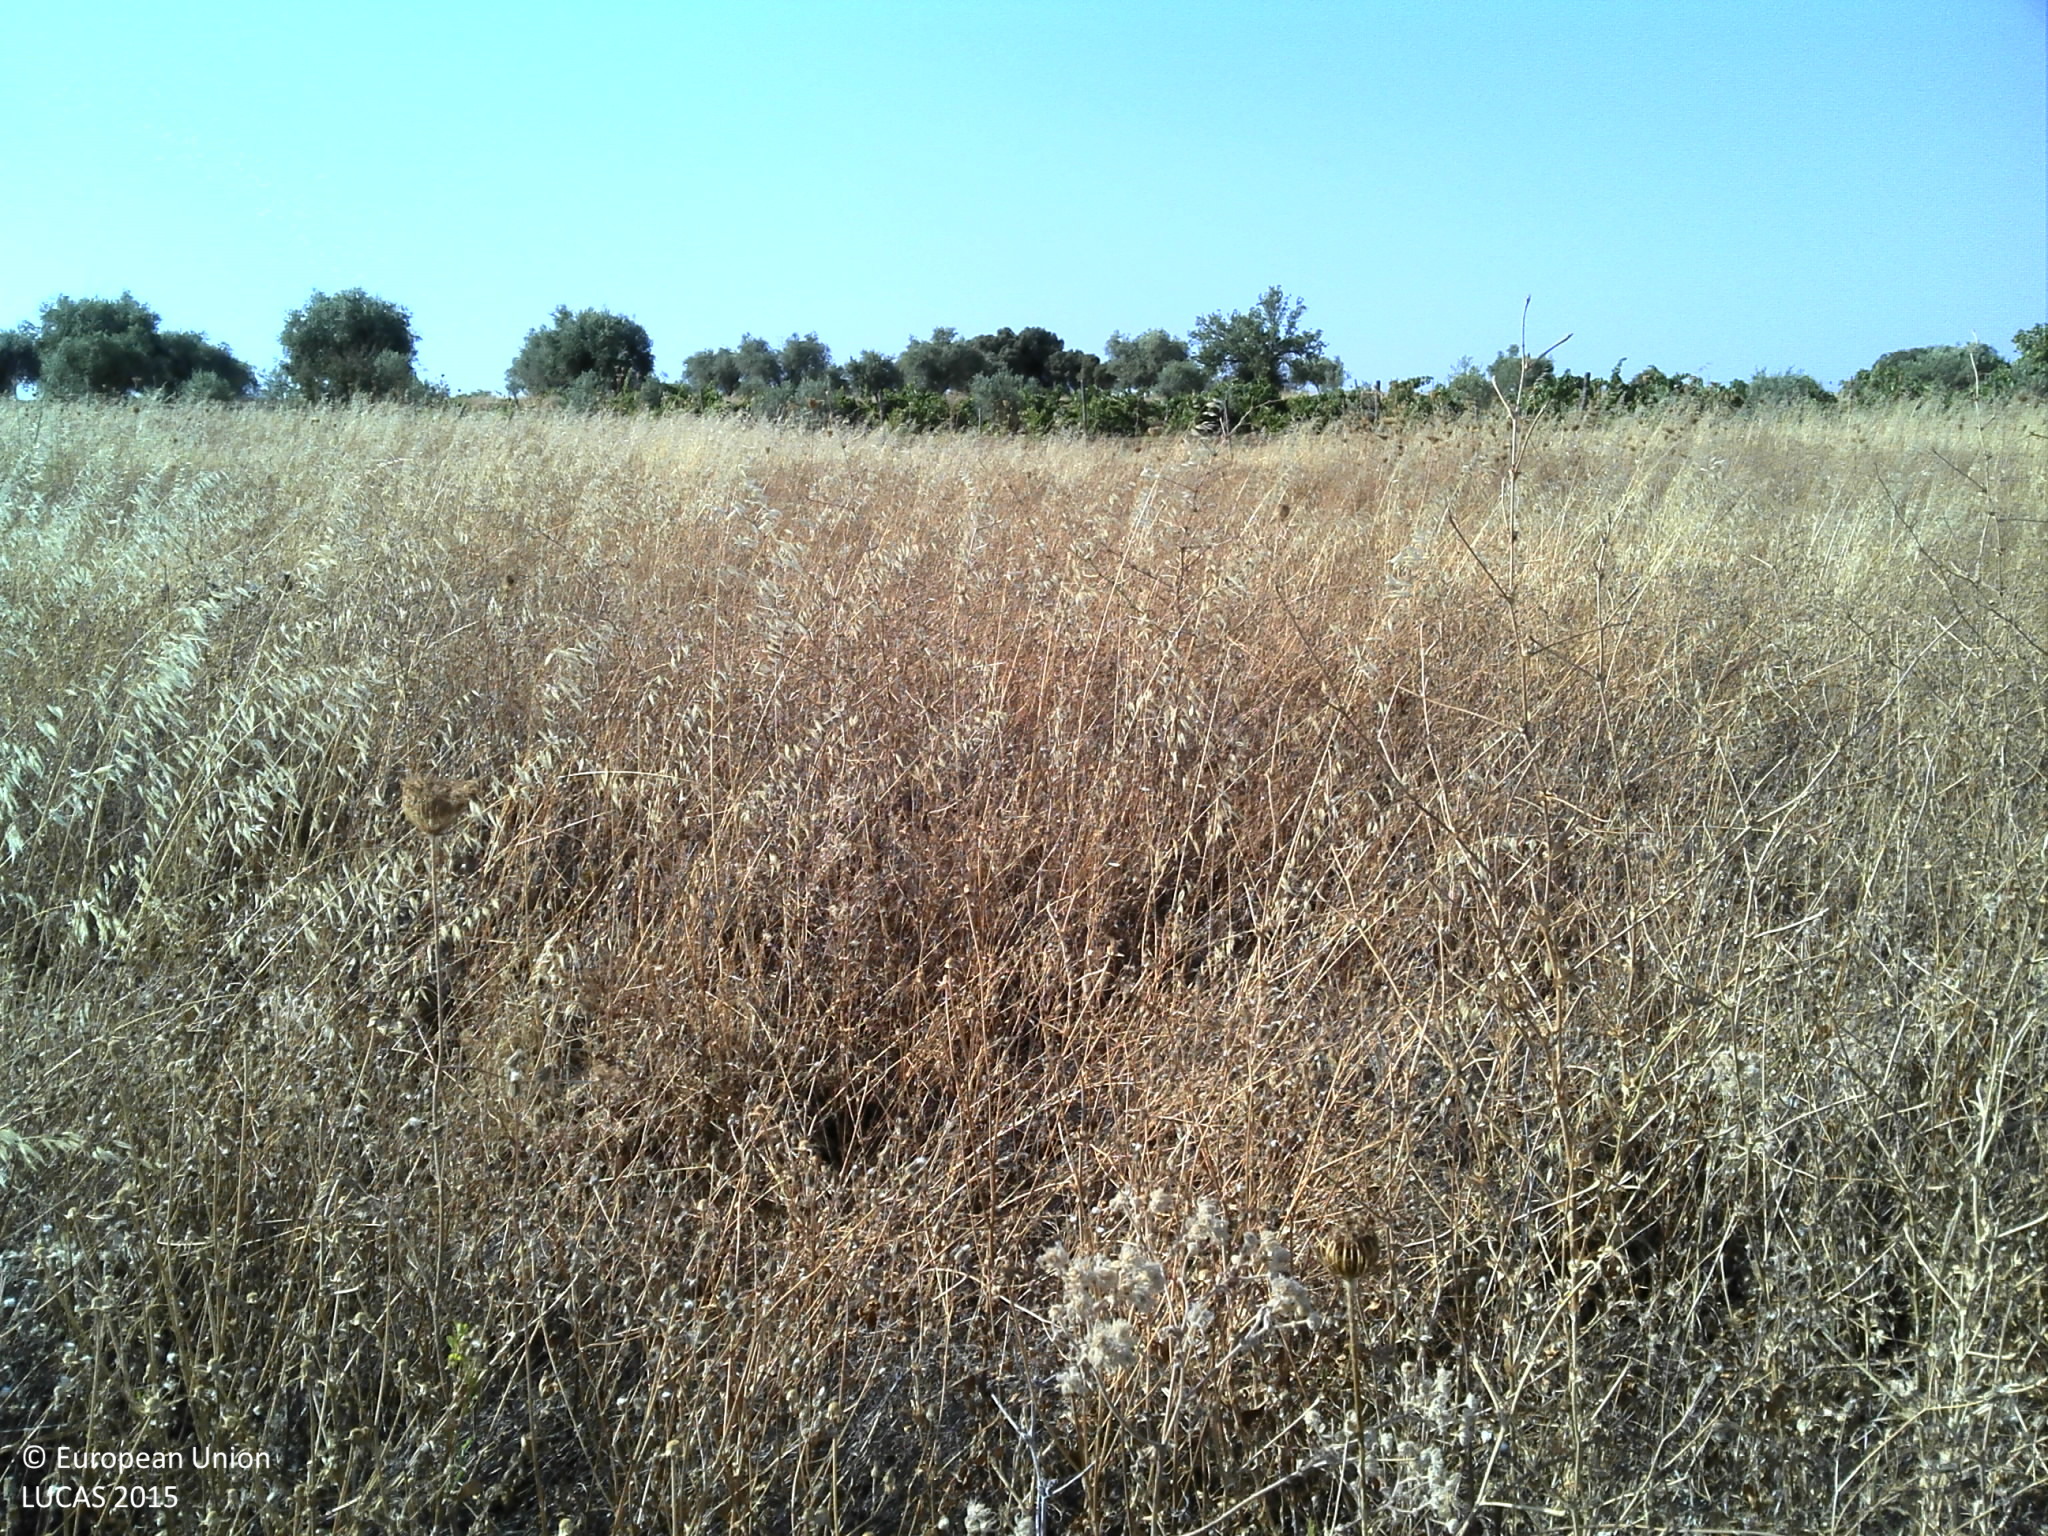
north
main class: Grassland
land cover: Grassland without tree/shrub cover
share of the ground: > 75 %
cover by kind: herbaceous plants 100 %
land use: Agriculture (excluding fallow land and kitchen gardens)
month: June
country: PT
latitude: 38.2810
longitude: -7.3634
